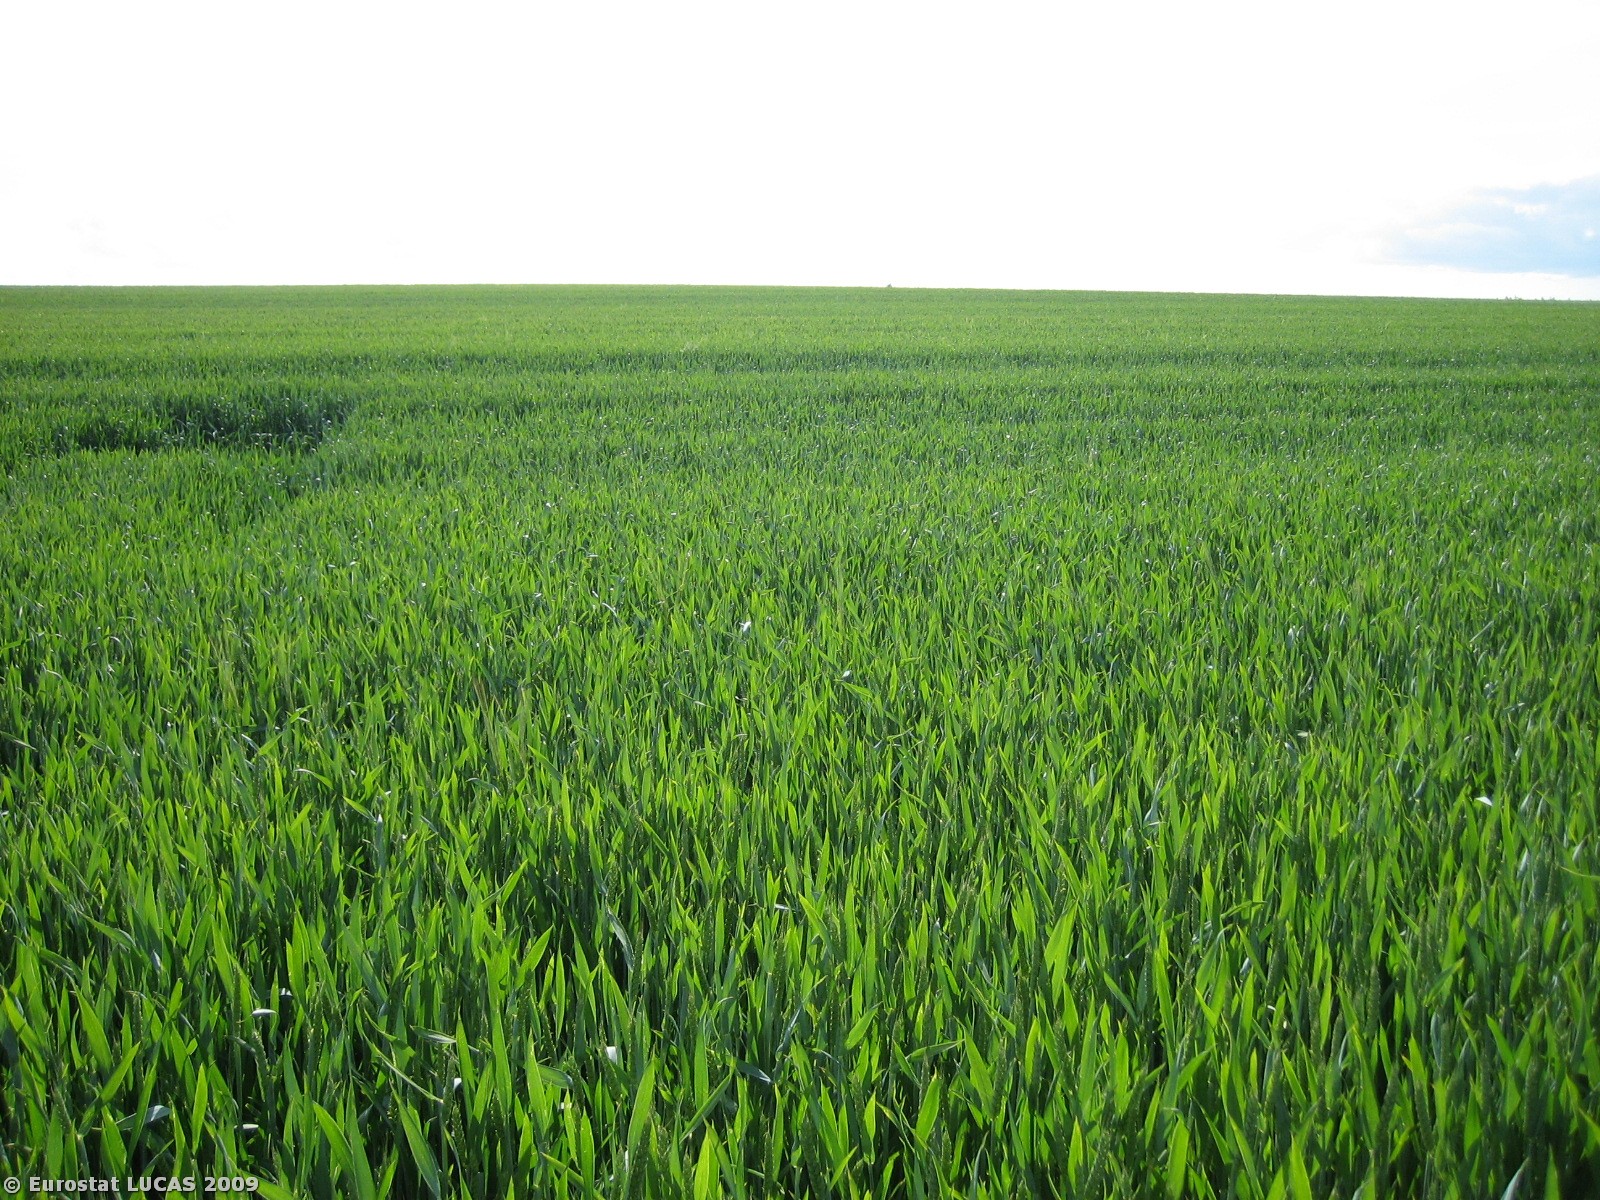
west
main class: Cropland
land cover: Common wheat
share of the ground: > 75 %
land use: Agriculture (excluding fallow land and kitchen gardens)
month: June
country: DK
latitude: 56.1515
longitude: 9.7267
